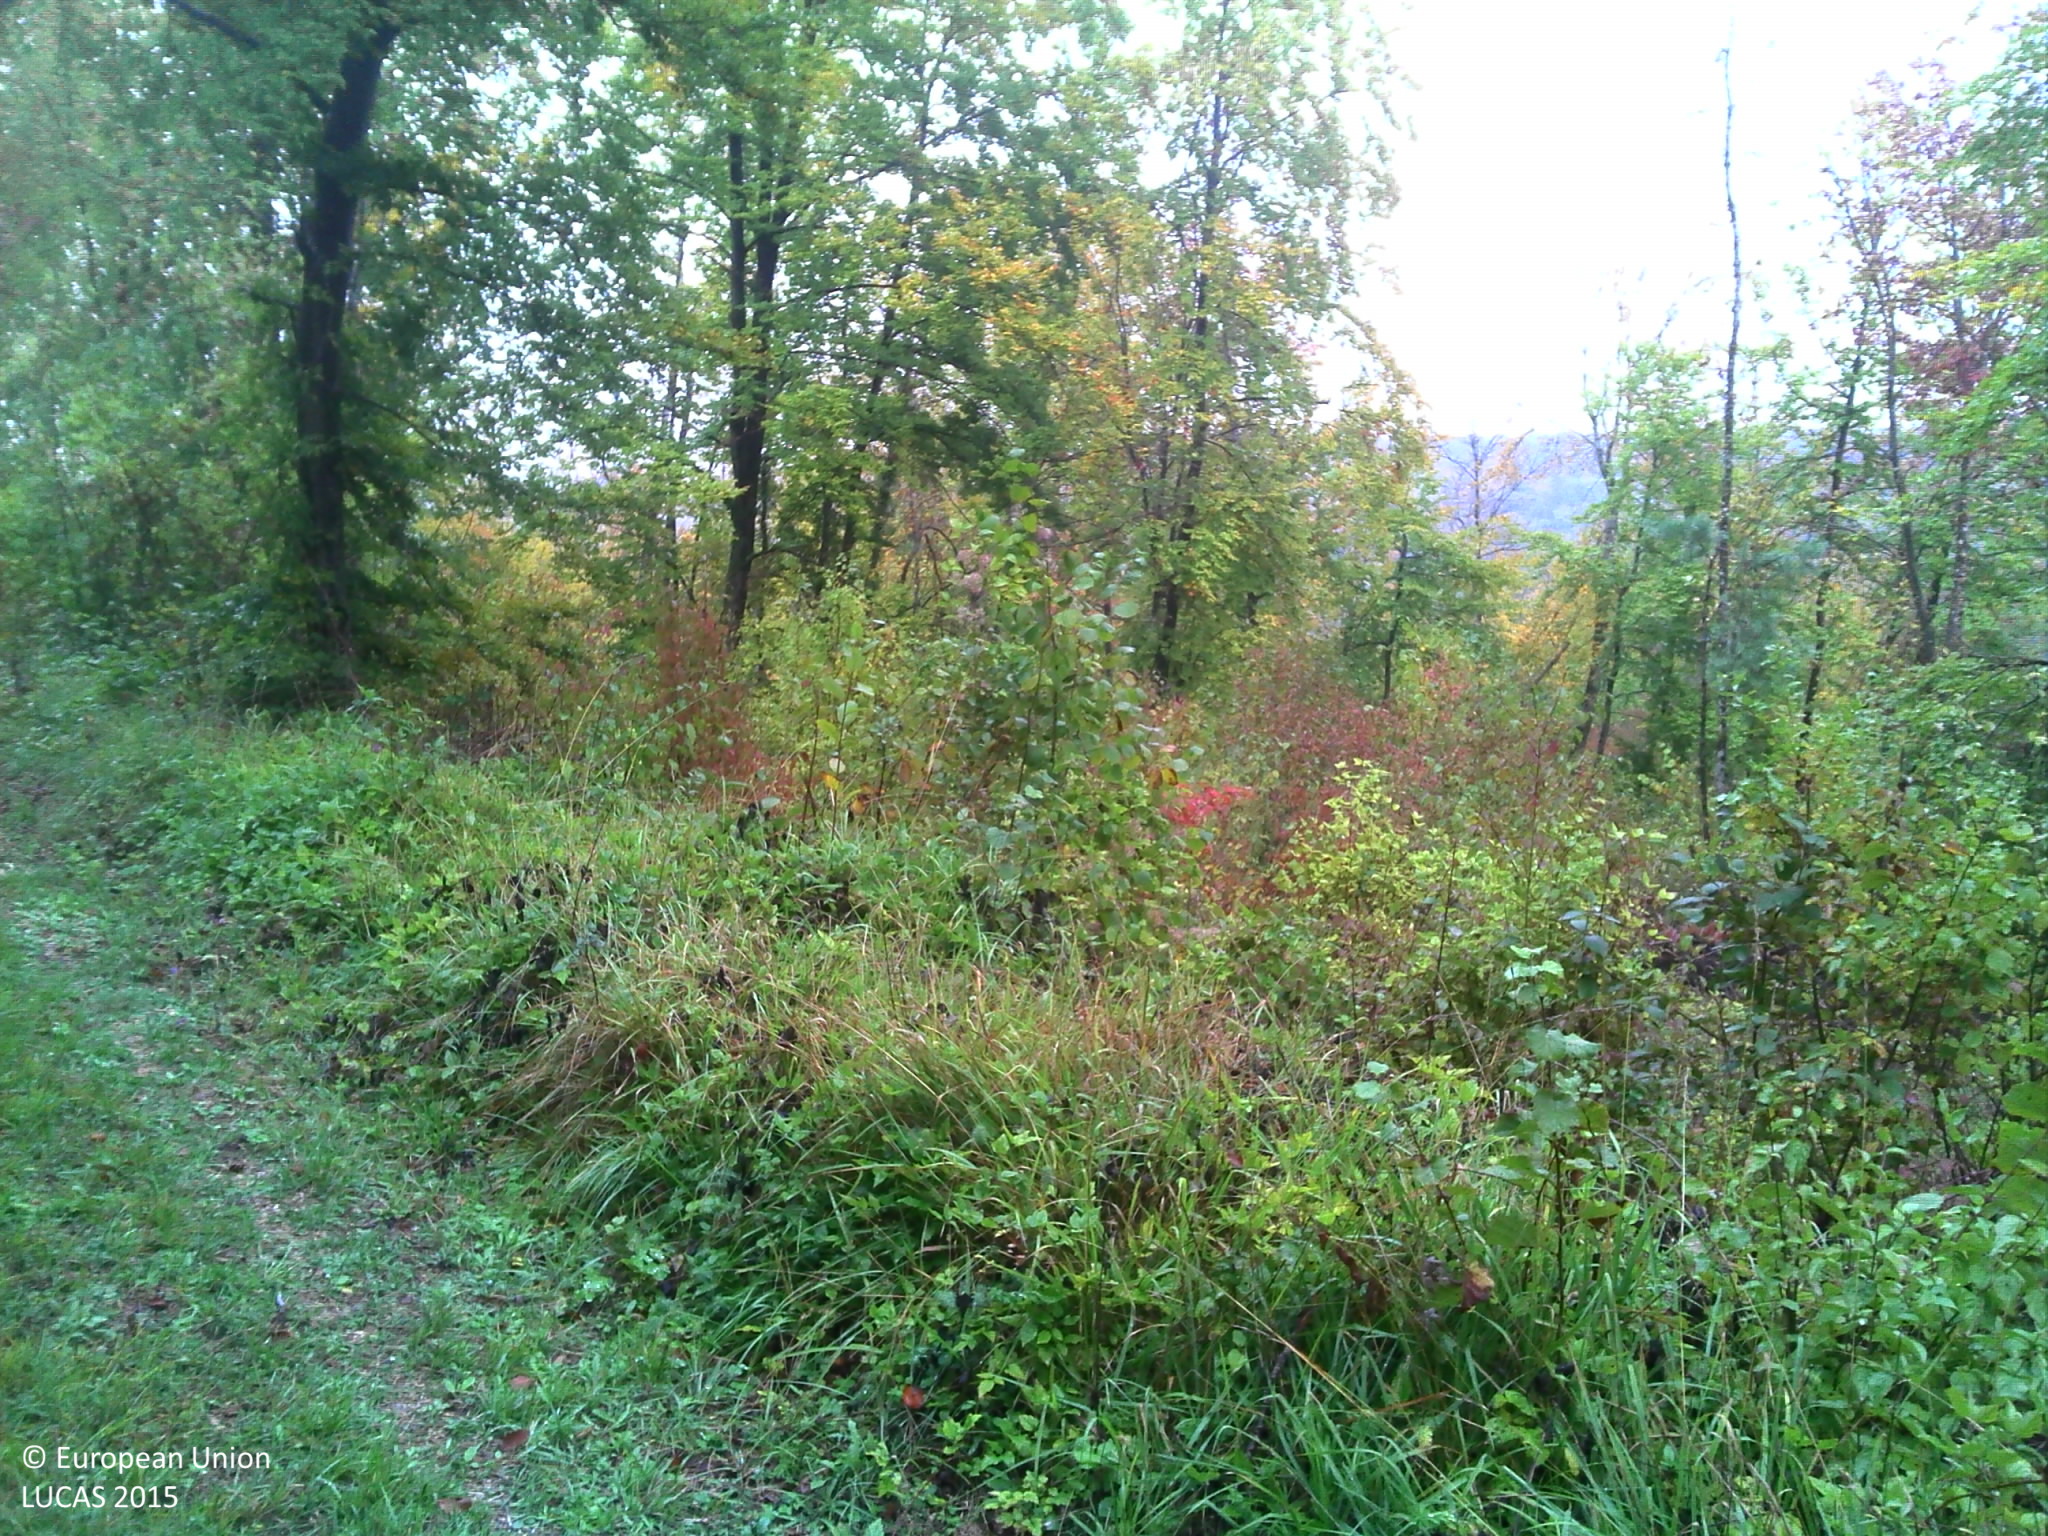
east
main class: Woodland
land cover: Broadleaved woodland
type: mesophytic deciduous forest
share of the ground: > 75 %
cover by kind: broadleaved forest trees 95 %, shrubs 5 %
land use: Forestry
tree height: > 5 m
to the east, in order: Broadleaved woodland; Tracks; Spontaneously vegetated surfaces; Broadleaved woodland; Spontaneously vegetated surfaces; Broadleaved woodland; Grassland without tree/shrub cover; Ditches and canals; Grass margins; Paved roads, cycling and walking lanes; Grass margins; Grassland without tree/shrub cover
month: October
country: FR
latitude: 47.6477
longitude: 5.1410
